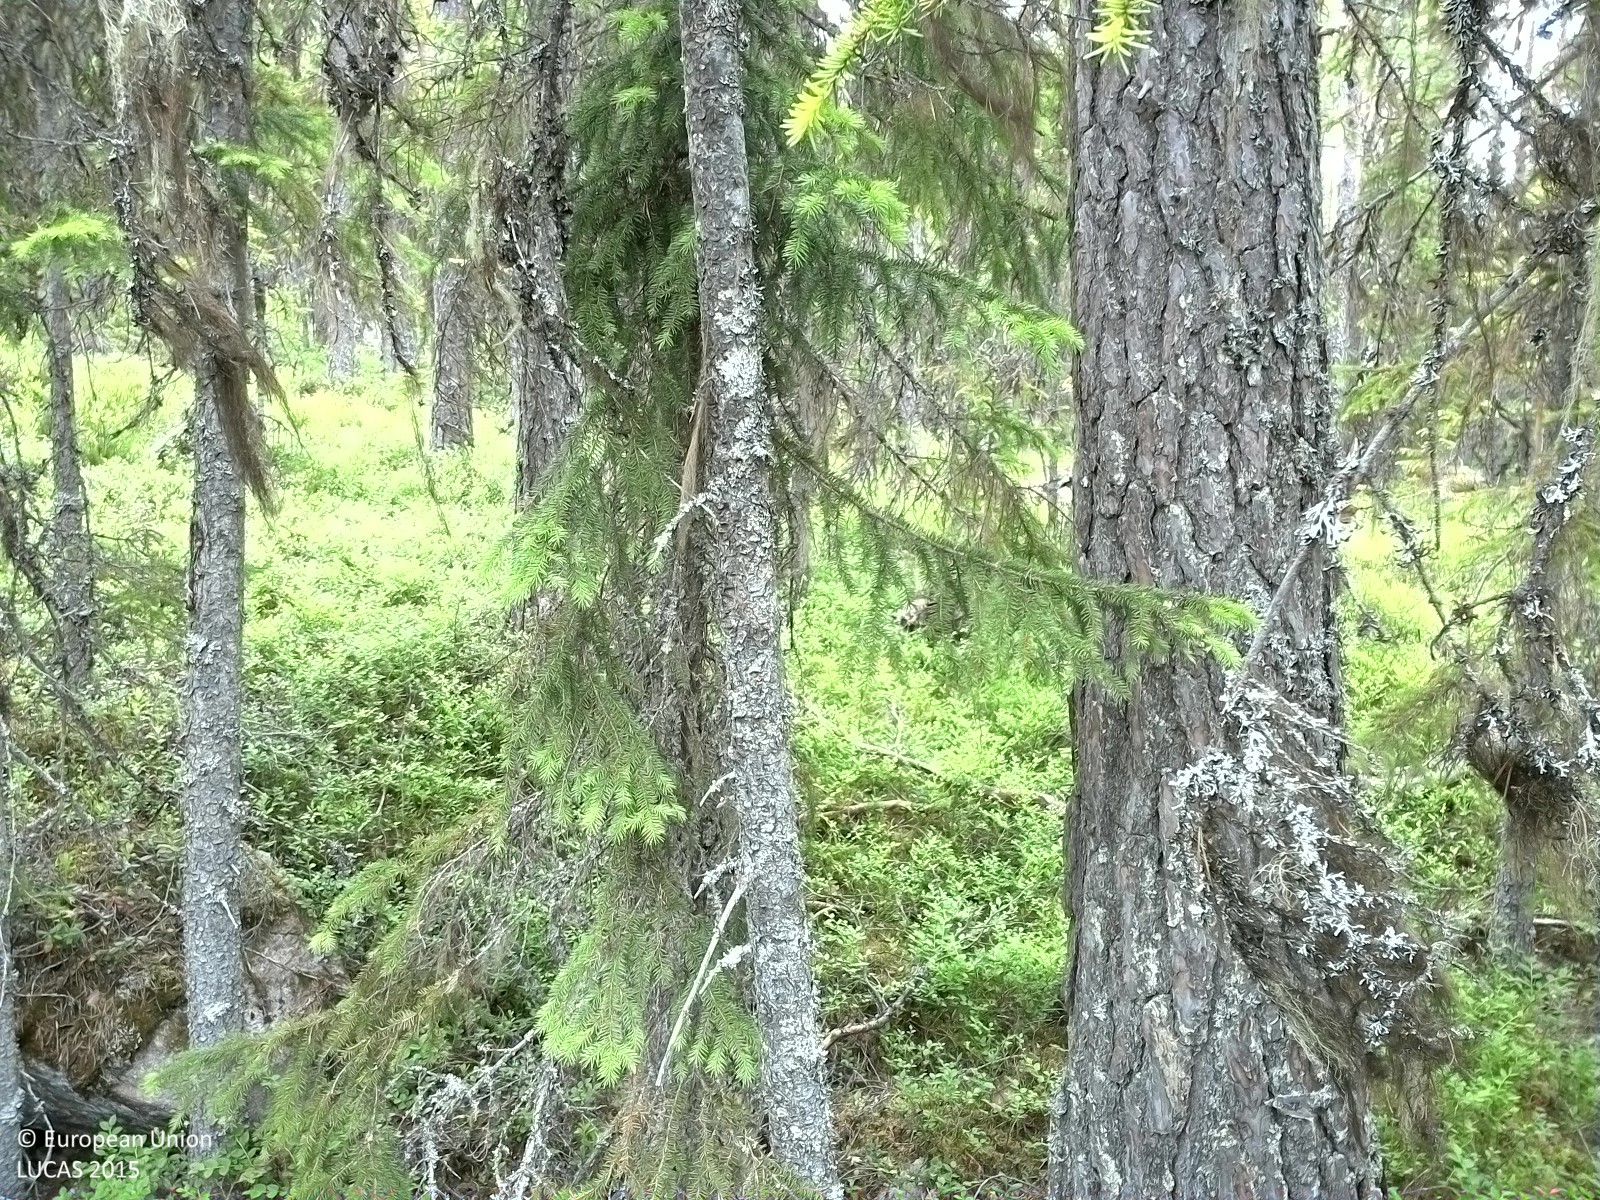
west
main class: Woodland
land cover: Pine dominated coniferous woodland
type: boreal forest
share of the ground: 50 - 75 %
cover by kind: coniferous forest trees 50 %, lichens and mosses 30 %, shrubs 20 %
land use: Forestry
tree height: > 5 m
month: June
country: SE
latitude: 62.0866
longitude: 16.2043
